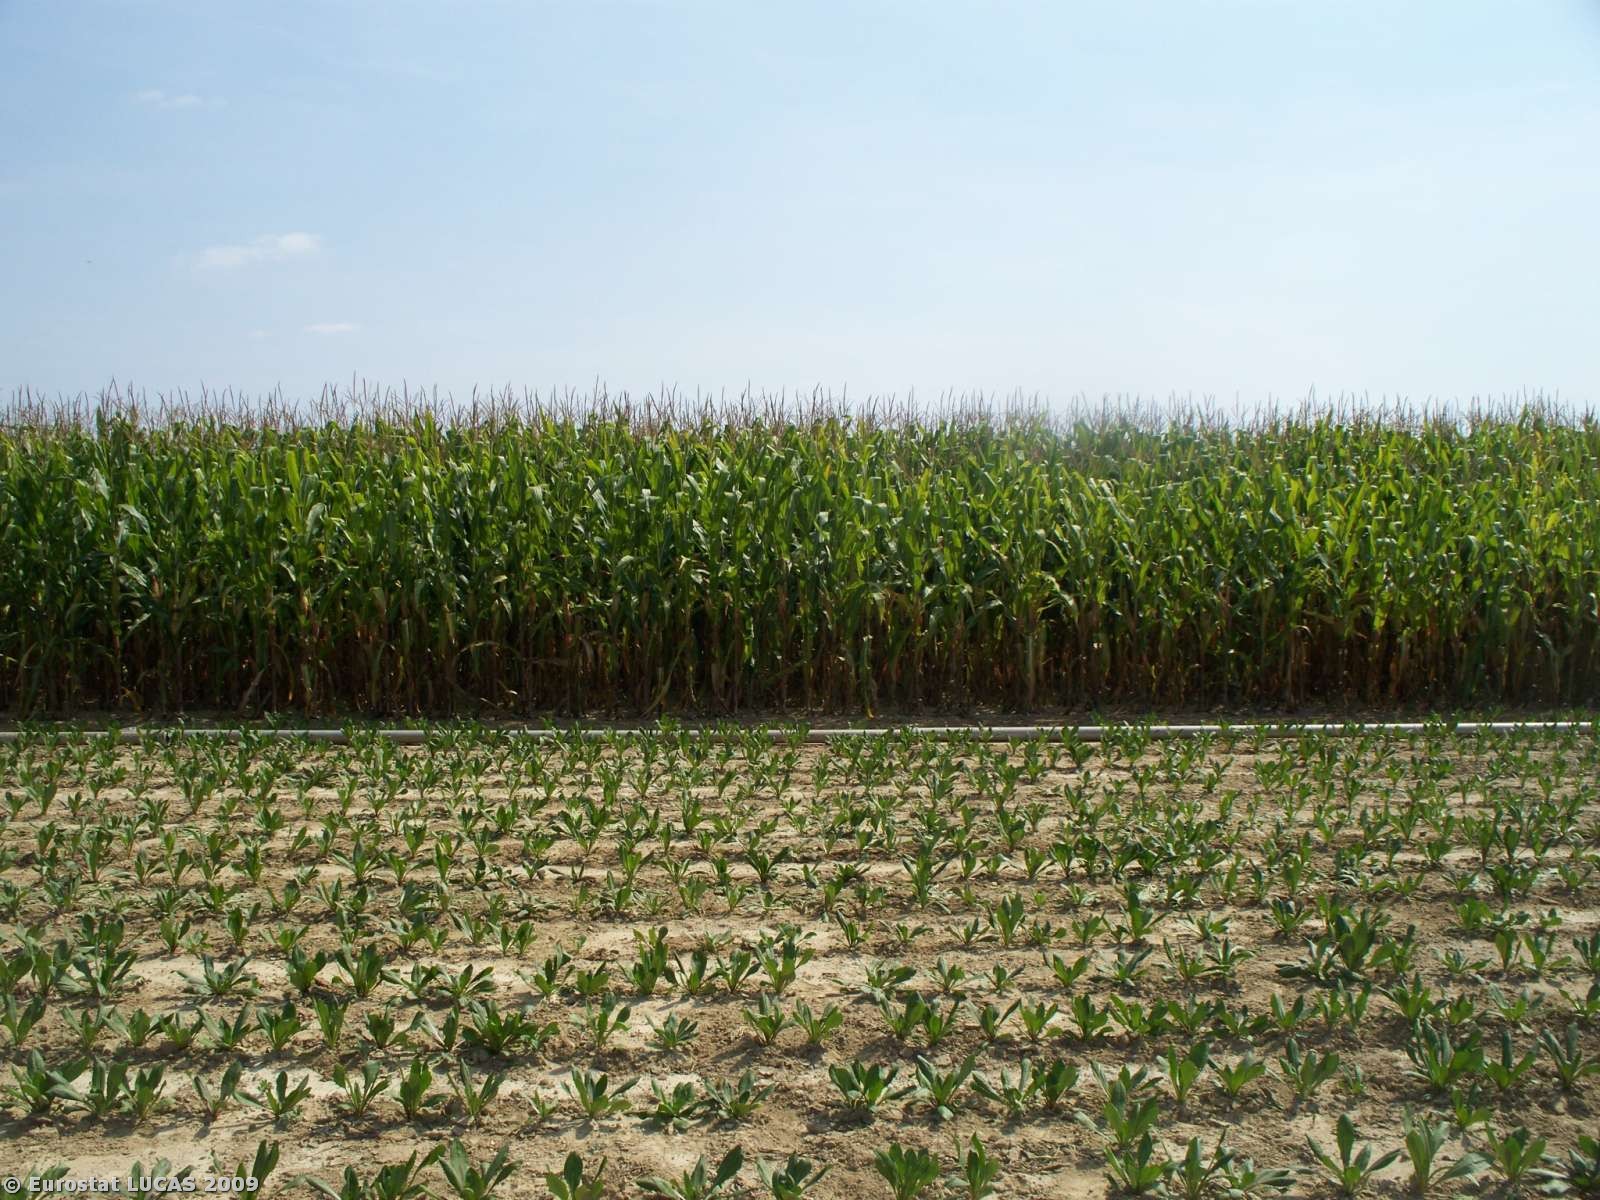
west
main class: Cropland
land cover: Other fresh vegetables
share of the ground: < 10 %
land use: Kitchen garden
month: May
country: IT
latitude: 45.5559
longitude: 12.0848
